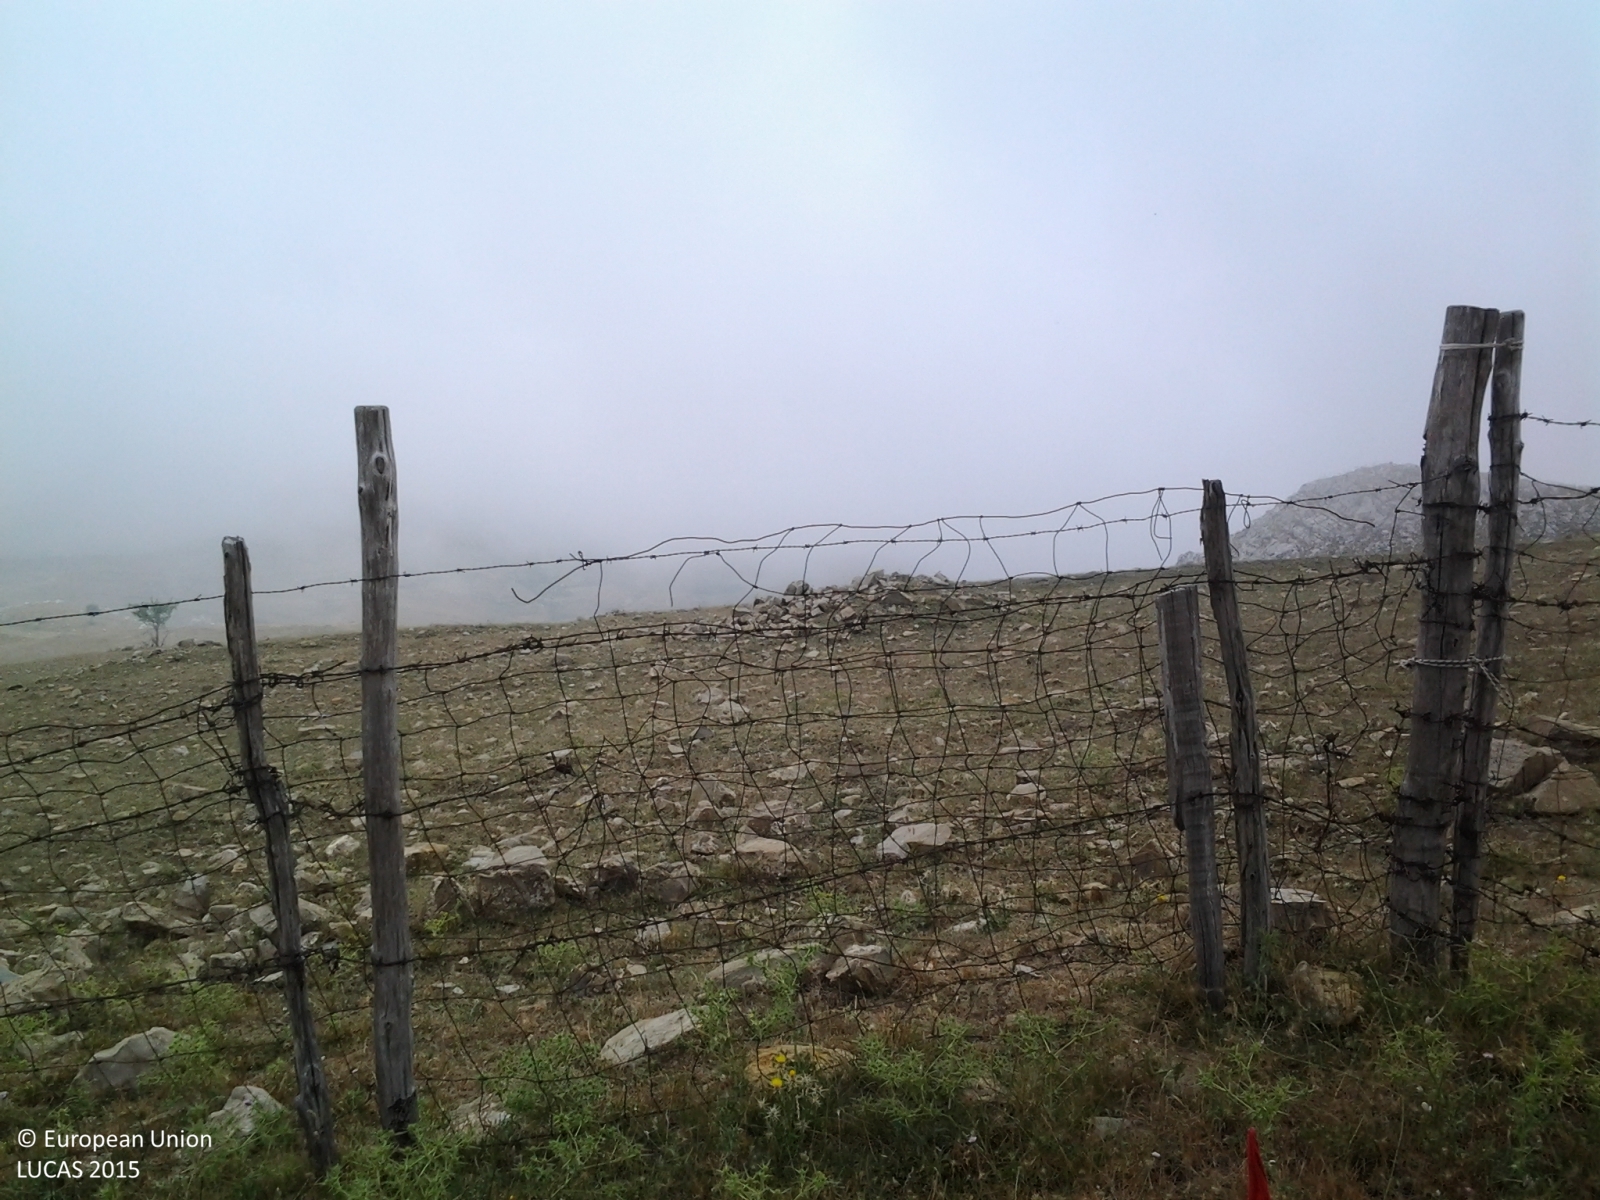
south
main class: Grassland
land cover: Spontaneously vegetated surfaces
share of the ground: > 75 %
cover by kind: herbaceous plants 90 %, shrubs 5 %, unconsolidated bare surface 5 %
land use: Agriculture (excluding fallow land and kitchen gardens)
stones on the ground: > 50 %
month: July
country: IT
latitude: 37.9691
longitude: 14.8507
